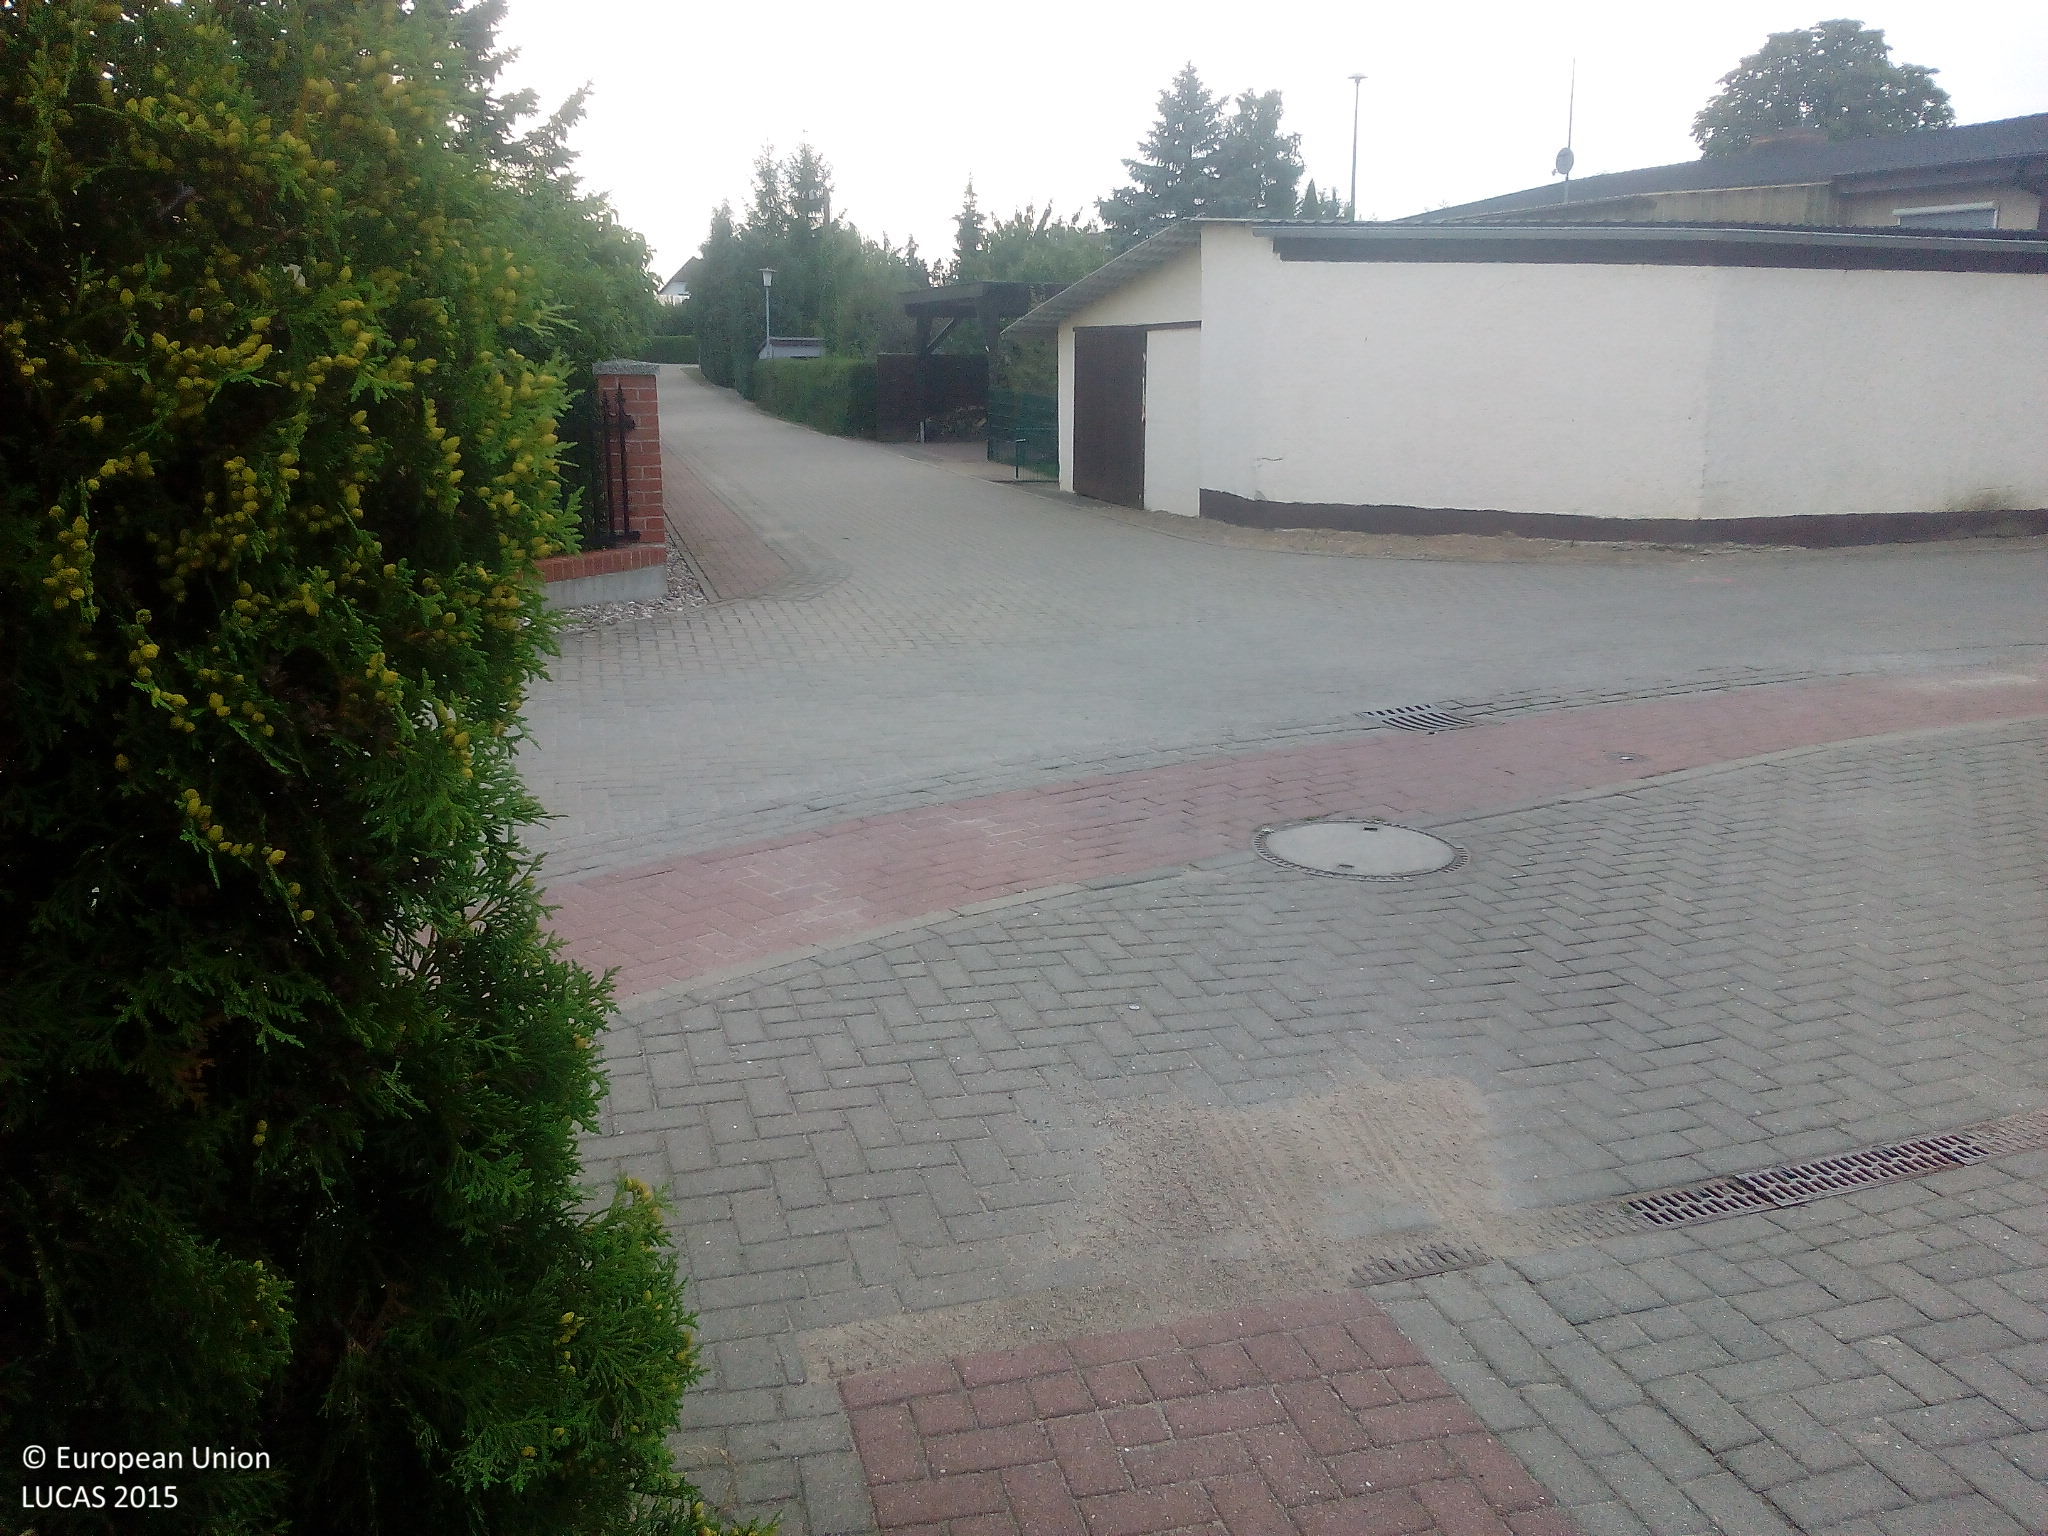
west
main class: Grassland
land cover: Grassland with sparse tree/shrub cover
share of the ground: > 75 %
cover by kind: herbaceous plants 85 %, shrubs 10 %, broadleaved forest trees 5 %
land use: Residential
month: August
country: DE
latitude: 53.5530
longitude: 12.6408
